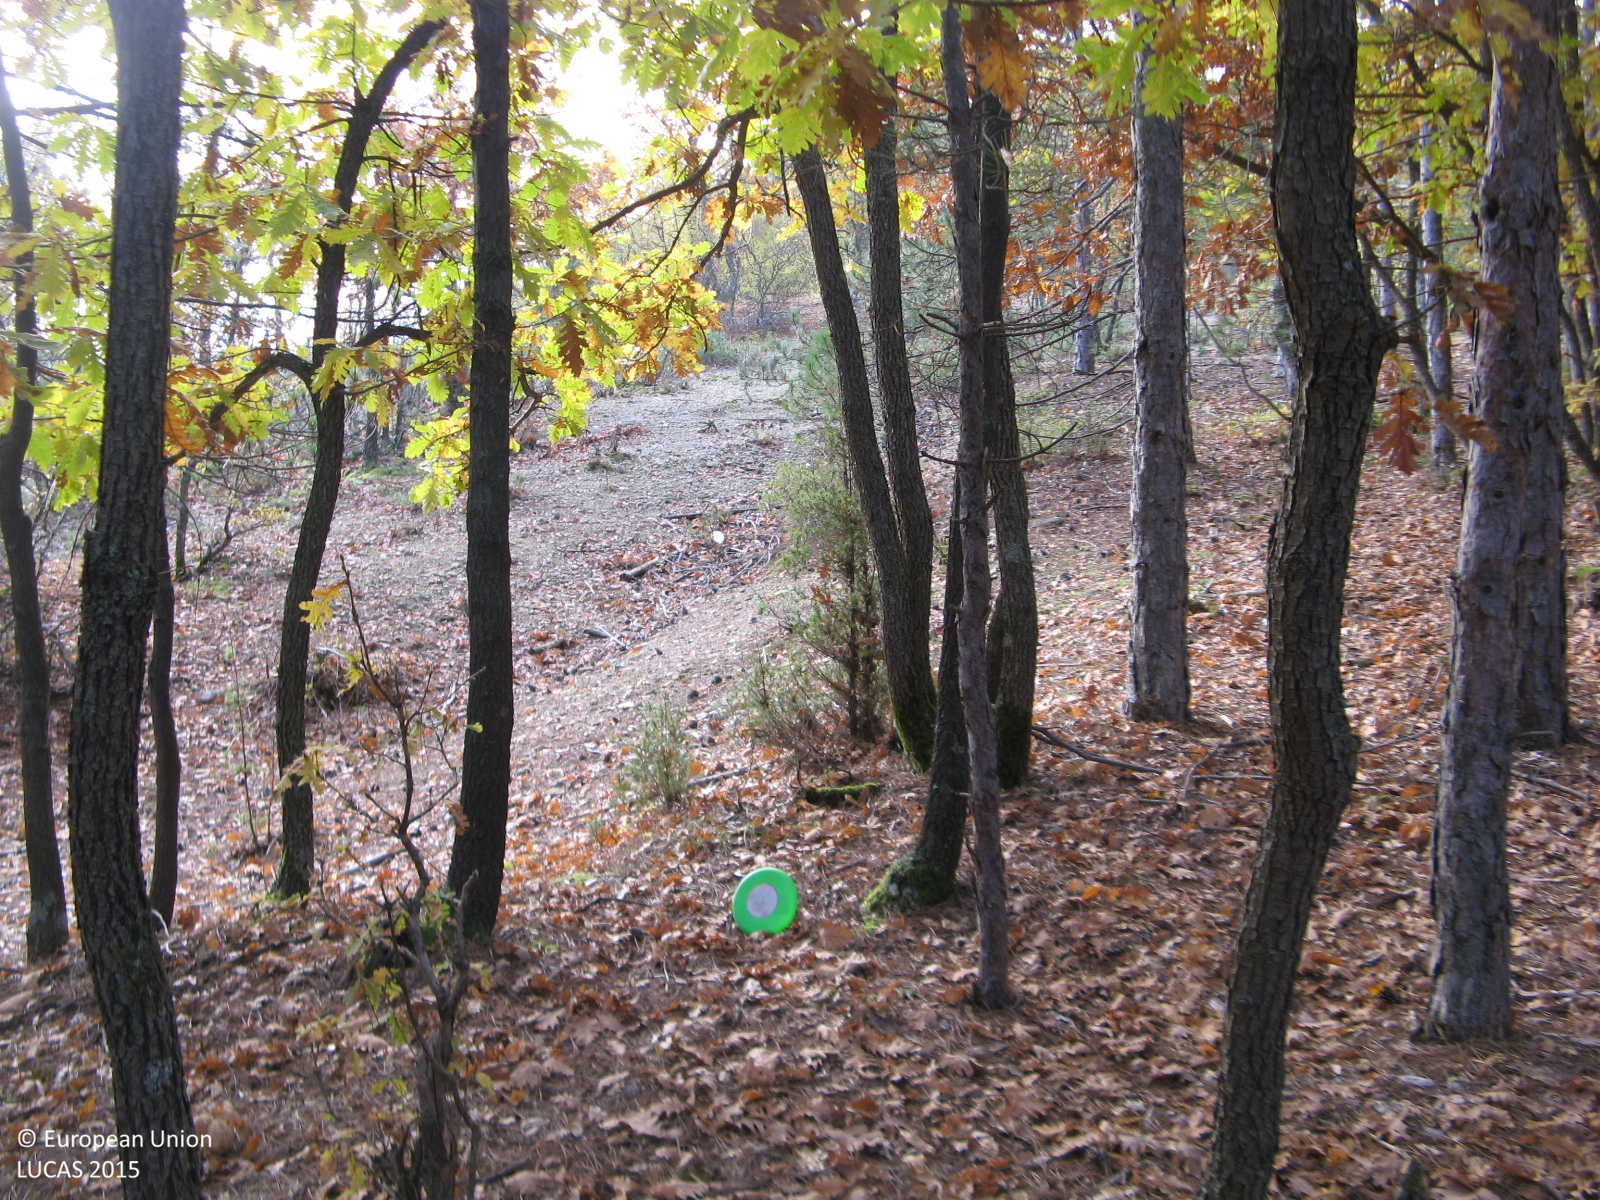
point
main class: Woodland
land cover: Pine dominated mixed woodland
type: hemiboreal forest and nemoral coniferous forest and mixed broadleaved-coniferous forest
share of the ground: > 75 %
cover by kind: coniferous forest trees 75 %, broadleaved forest trees 25 %
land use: Forestry
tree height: > 5 m
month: November
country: BG
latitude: 41.5191
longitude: 25.3084
